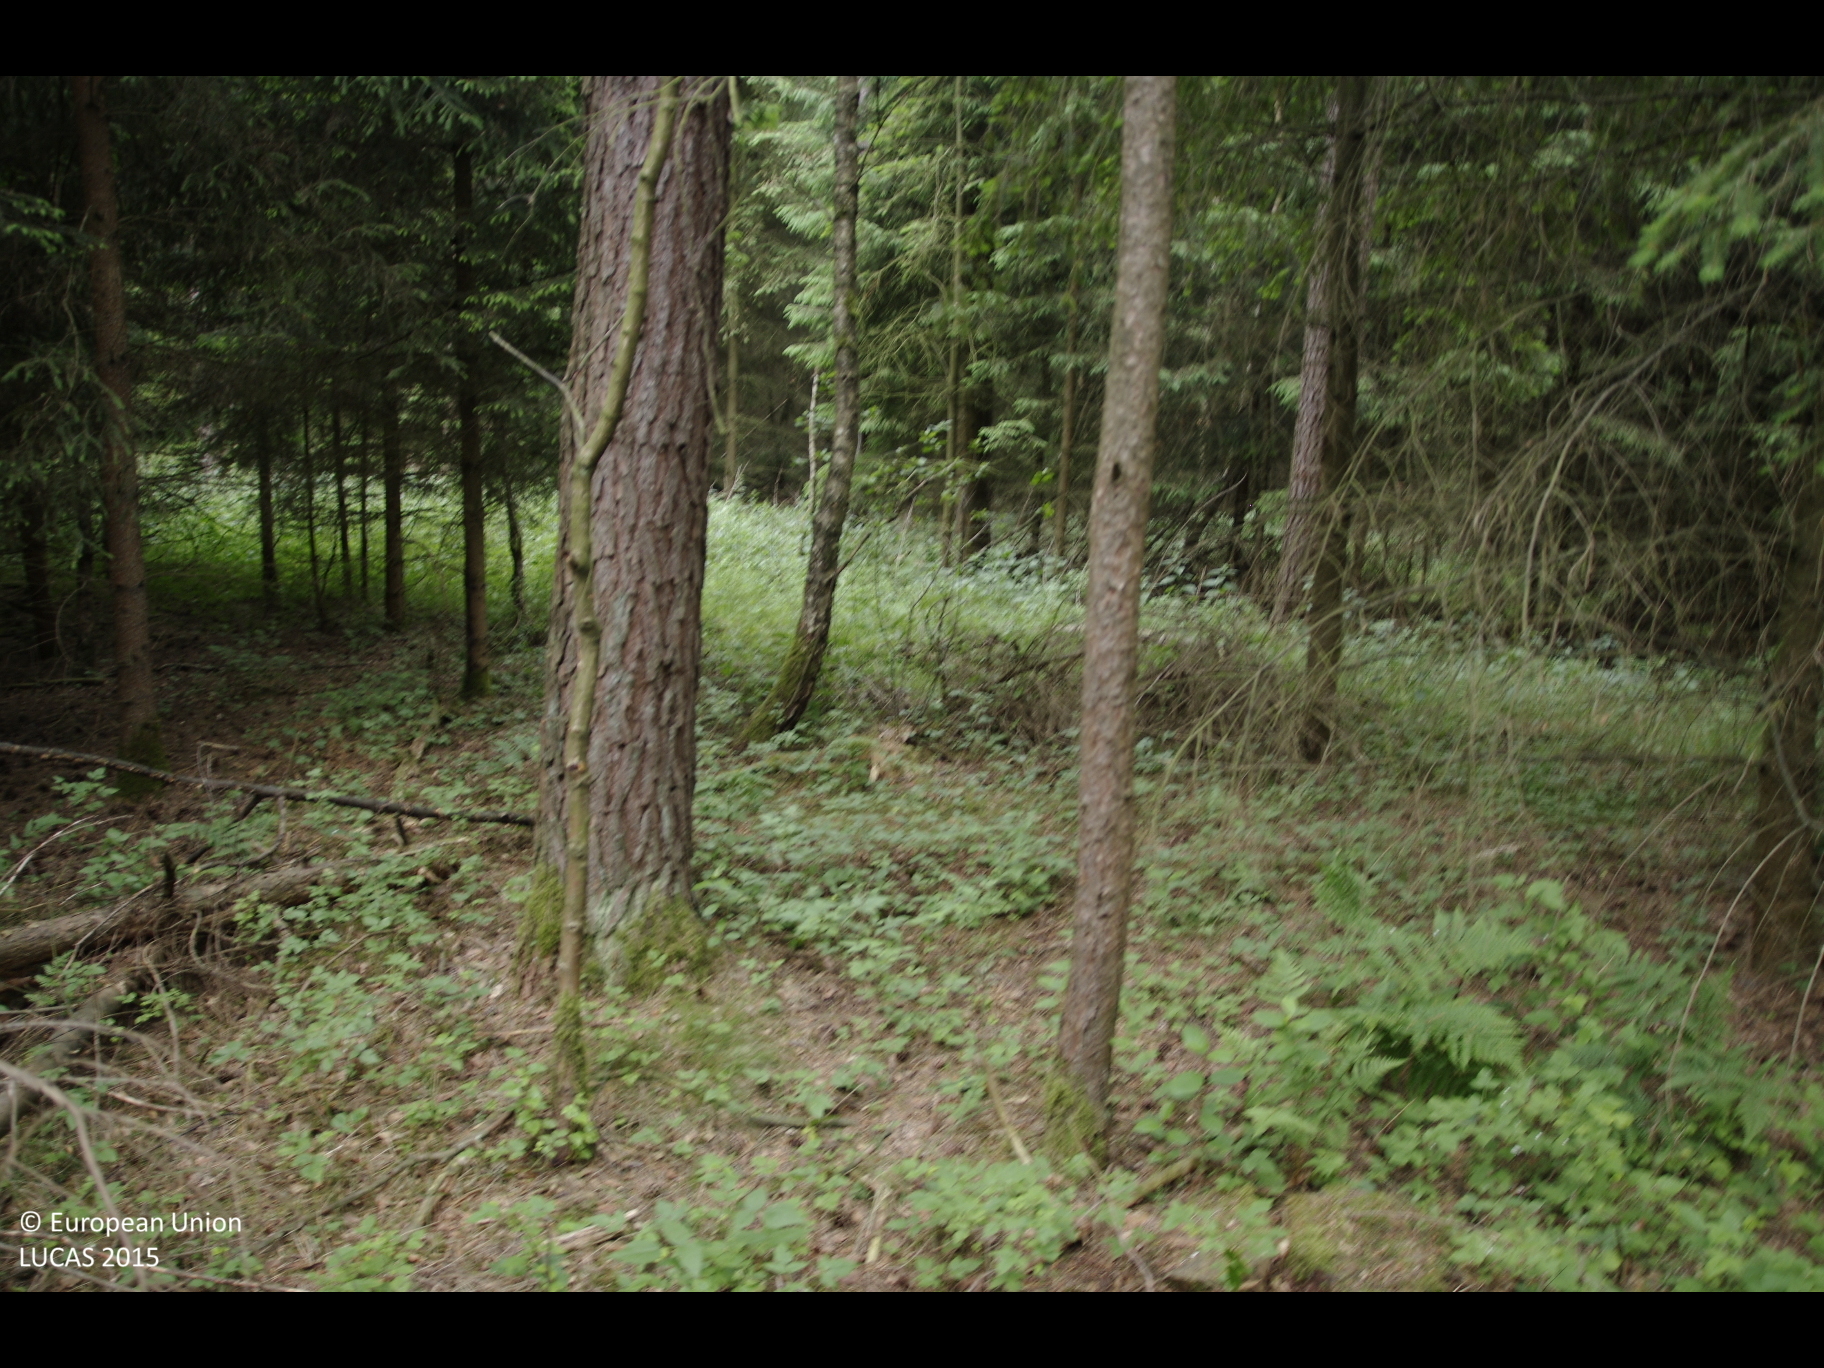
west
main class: Woodland
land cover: Other coniferous woodland
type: hemiboreal forest and nemoral coniferous forest and mixed broadleaved-coniferous forest
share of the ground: 50 - 75 %
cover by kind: coniferous forest trees 60 %, shrubs 10 %, herbaceous plants 10 %, unconsolidated bare surface 10 %, broadleaved forest trees 5 %, lichens and mosses 5 %
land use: Forestry
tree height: > 5 m
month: June
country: DE
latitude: 53.1679
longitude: 10.3140
